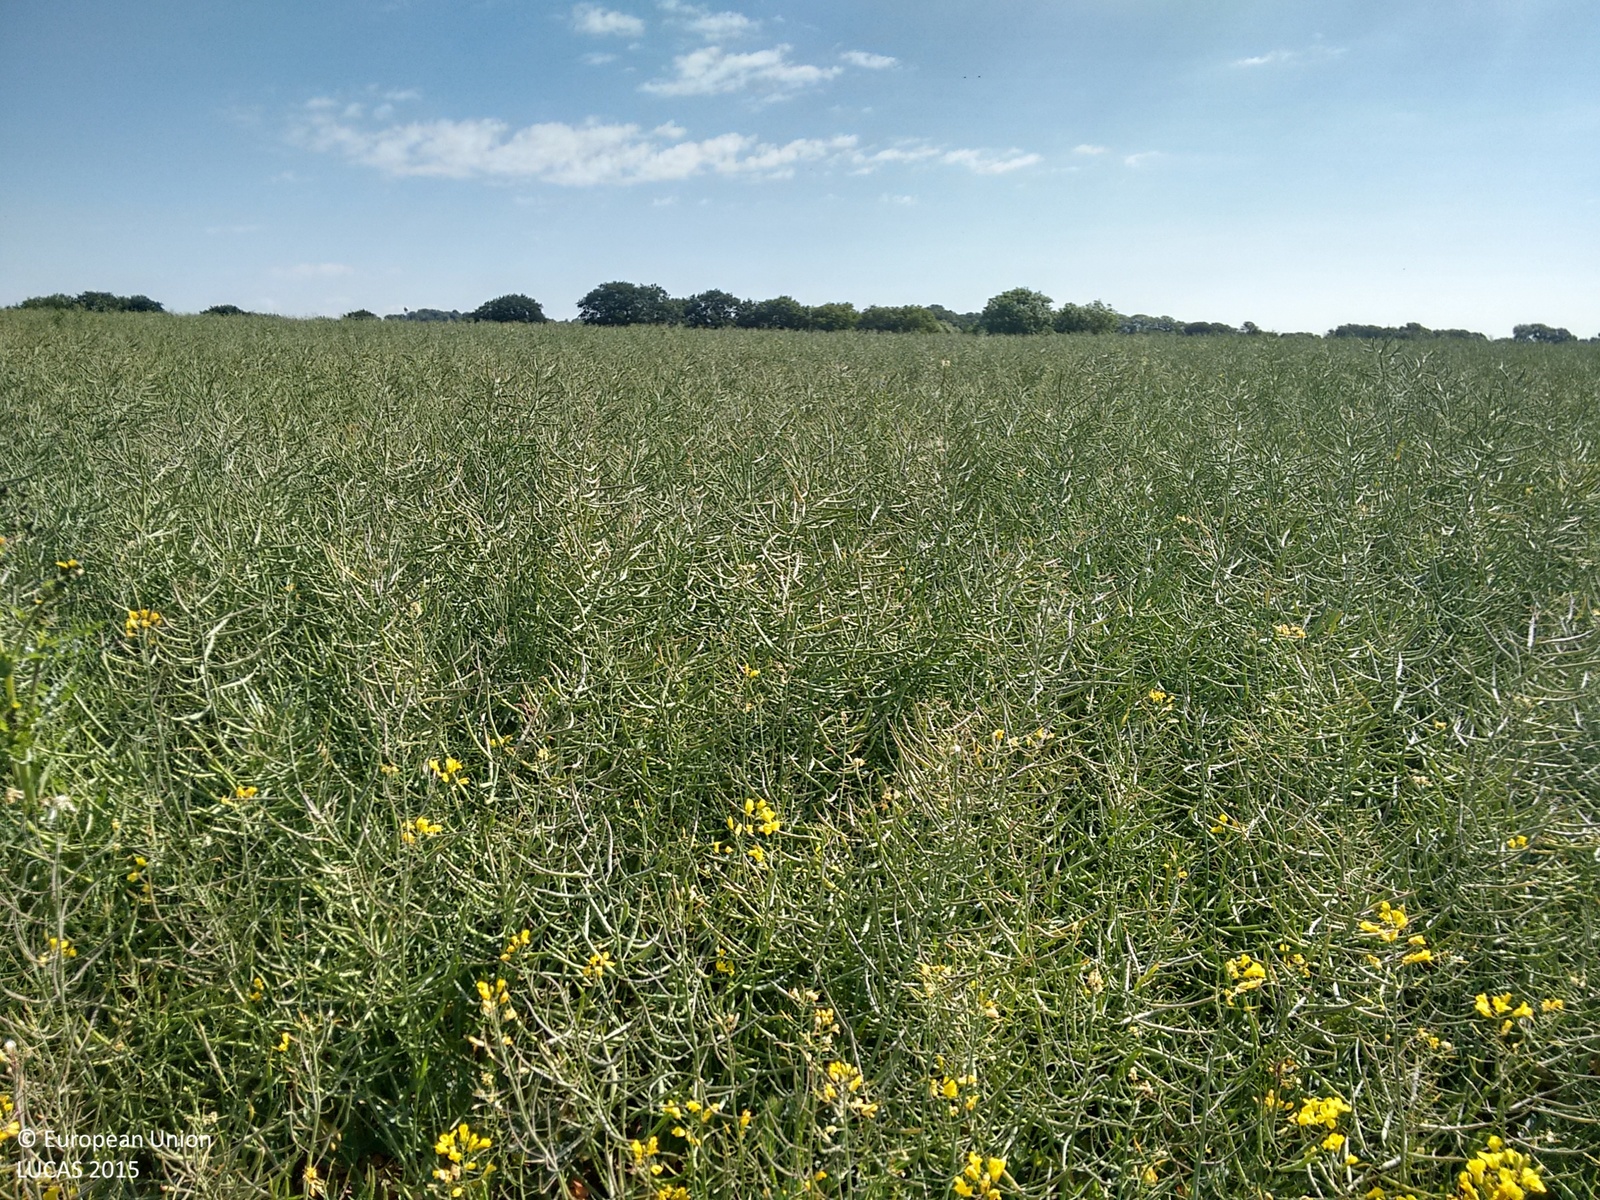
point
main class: Cropland
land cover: Rape and turnip rape
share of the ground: > 75 %
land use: Agriculture (excluding fallow land and kitchen gardens)
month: June
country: GB
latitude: 51.0180
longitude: -1.6715
